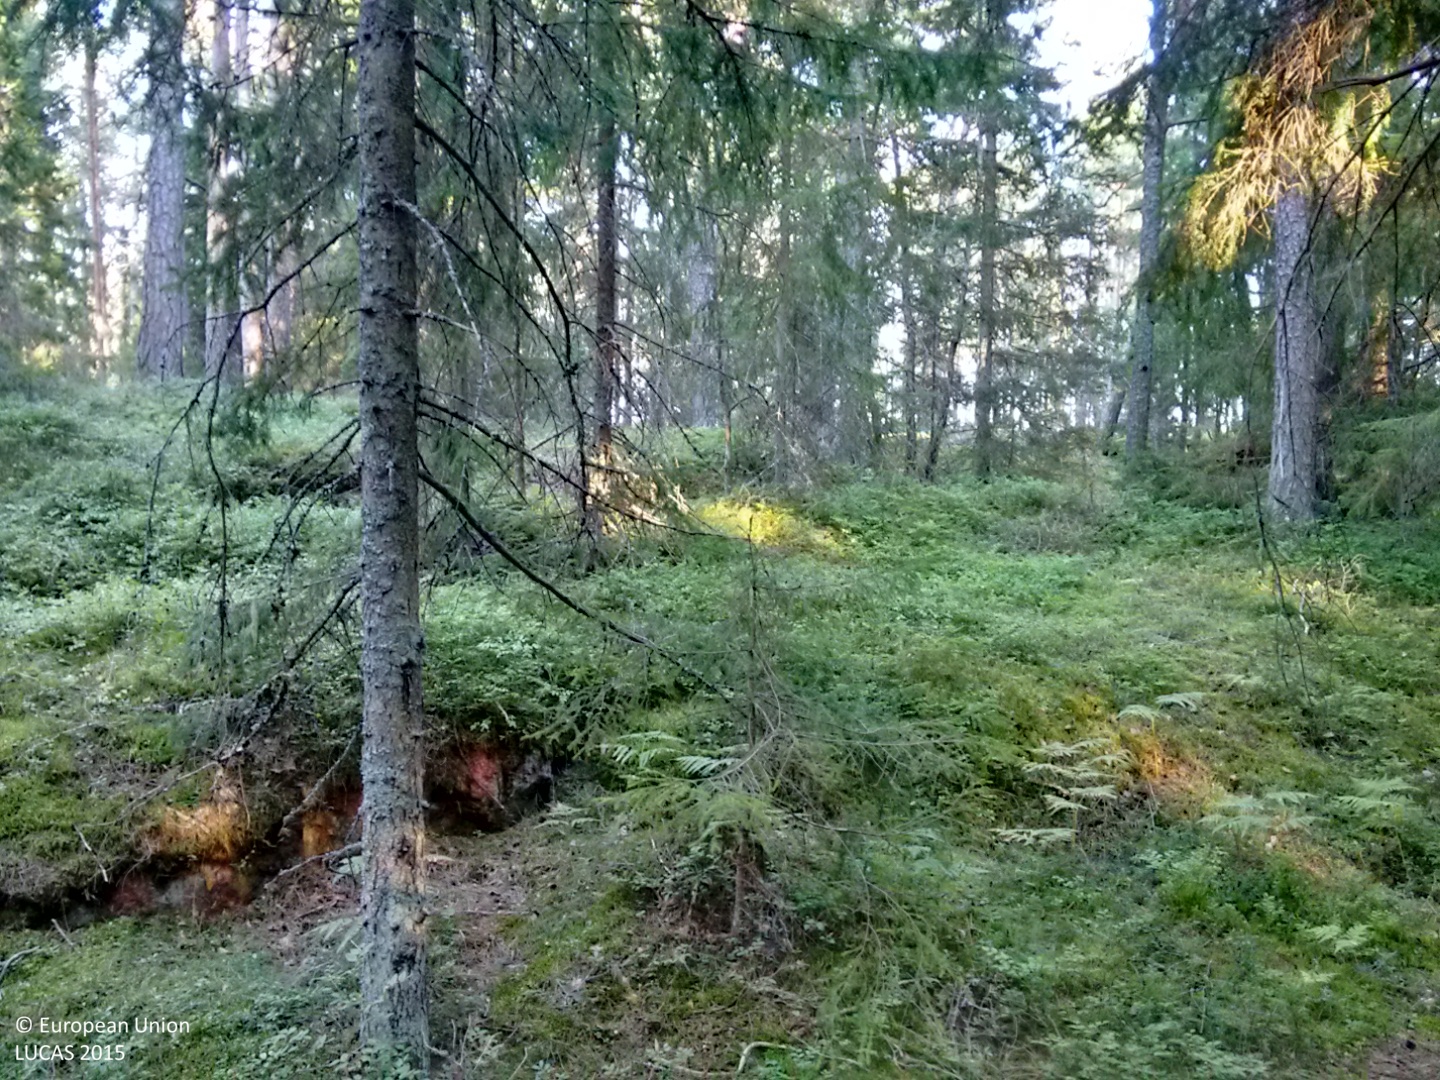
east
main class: Woodland
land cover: Pine dominated coniferous woodland
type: hemiboreal forest and nemoral coniferous forest and mixed broadleaved-coniferous forest
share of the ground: > 75 %
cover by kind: coniferous forest trees 85 %, shrubs 5 %, herbaceous plants 5 %, lichens and mosses 5 %
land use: Forestry
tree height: > 5 m
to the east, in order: Pine dominated coniferous woodland; Pine dominated mixed woodland; Spruce dominated coniferous woodland
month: August
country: FI
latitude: 60.2631
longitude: 19.9648
